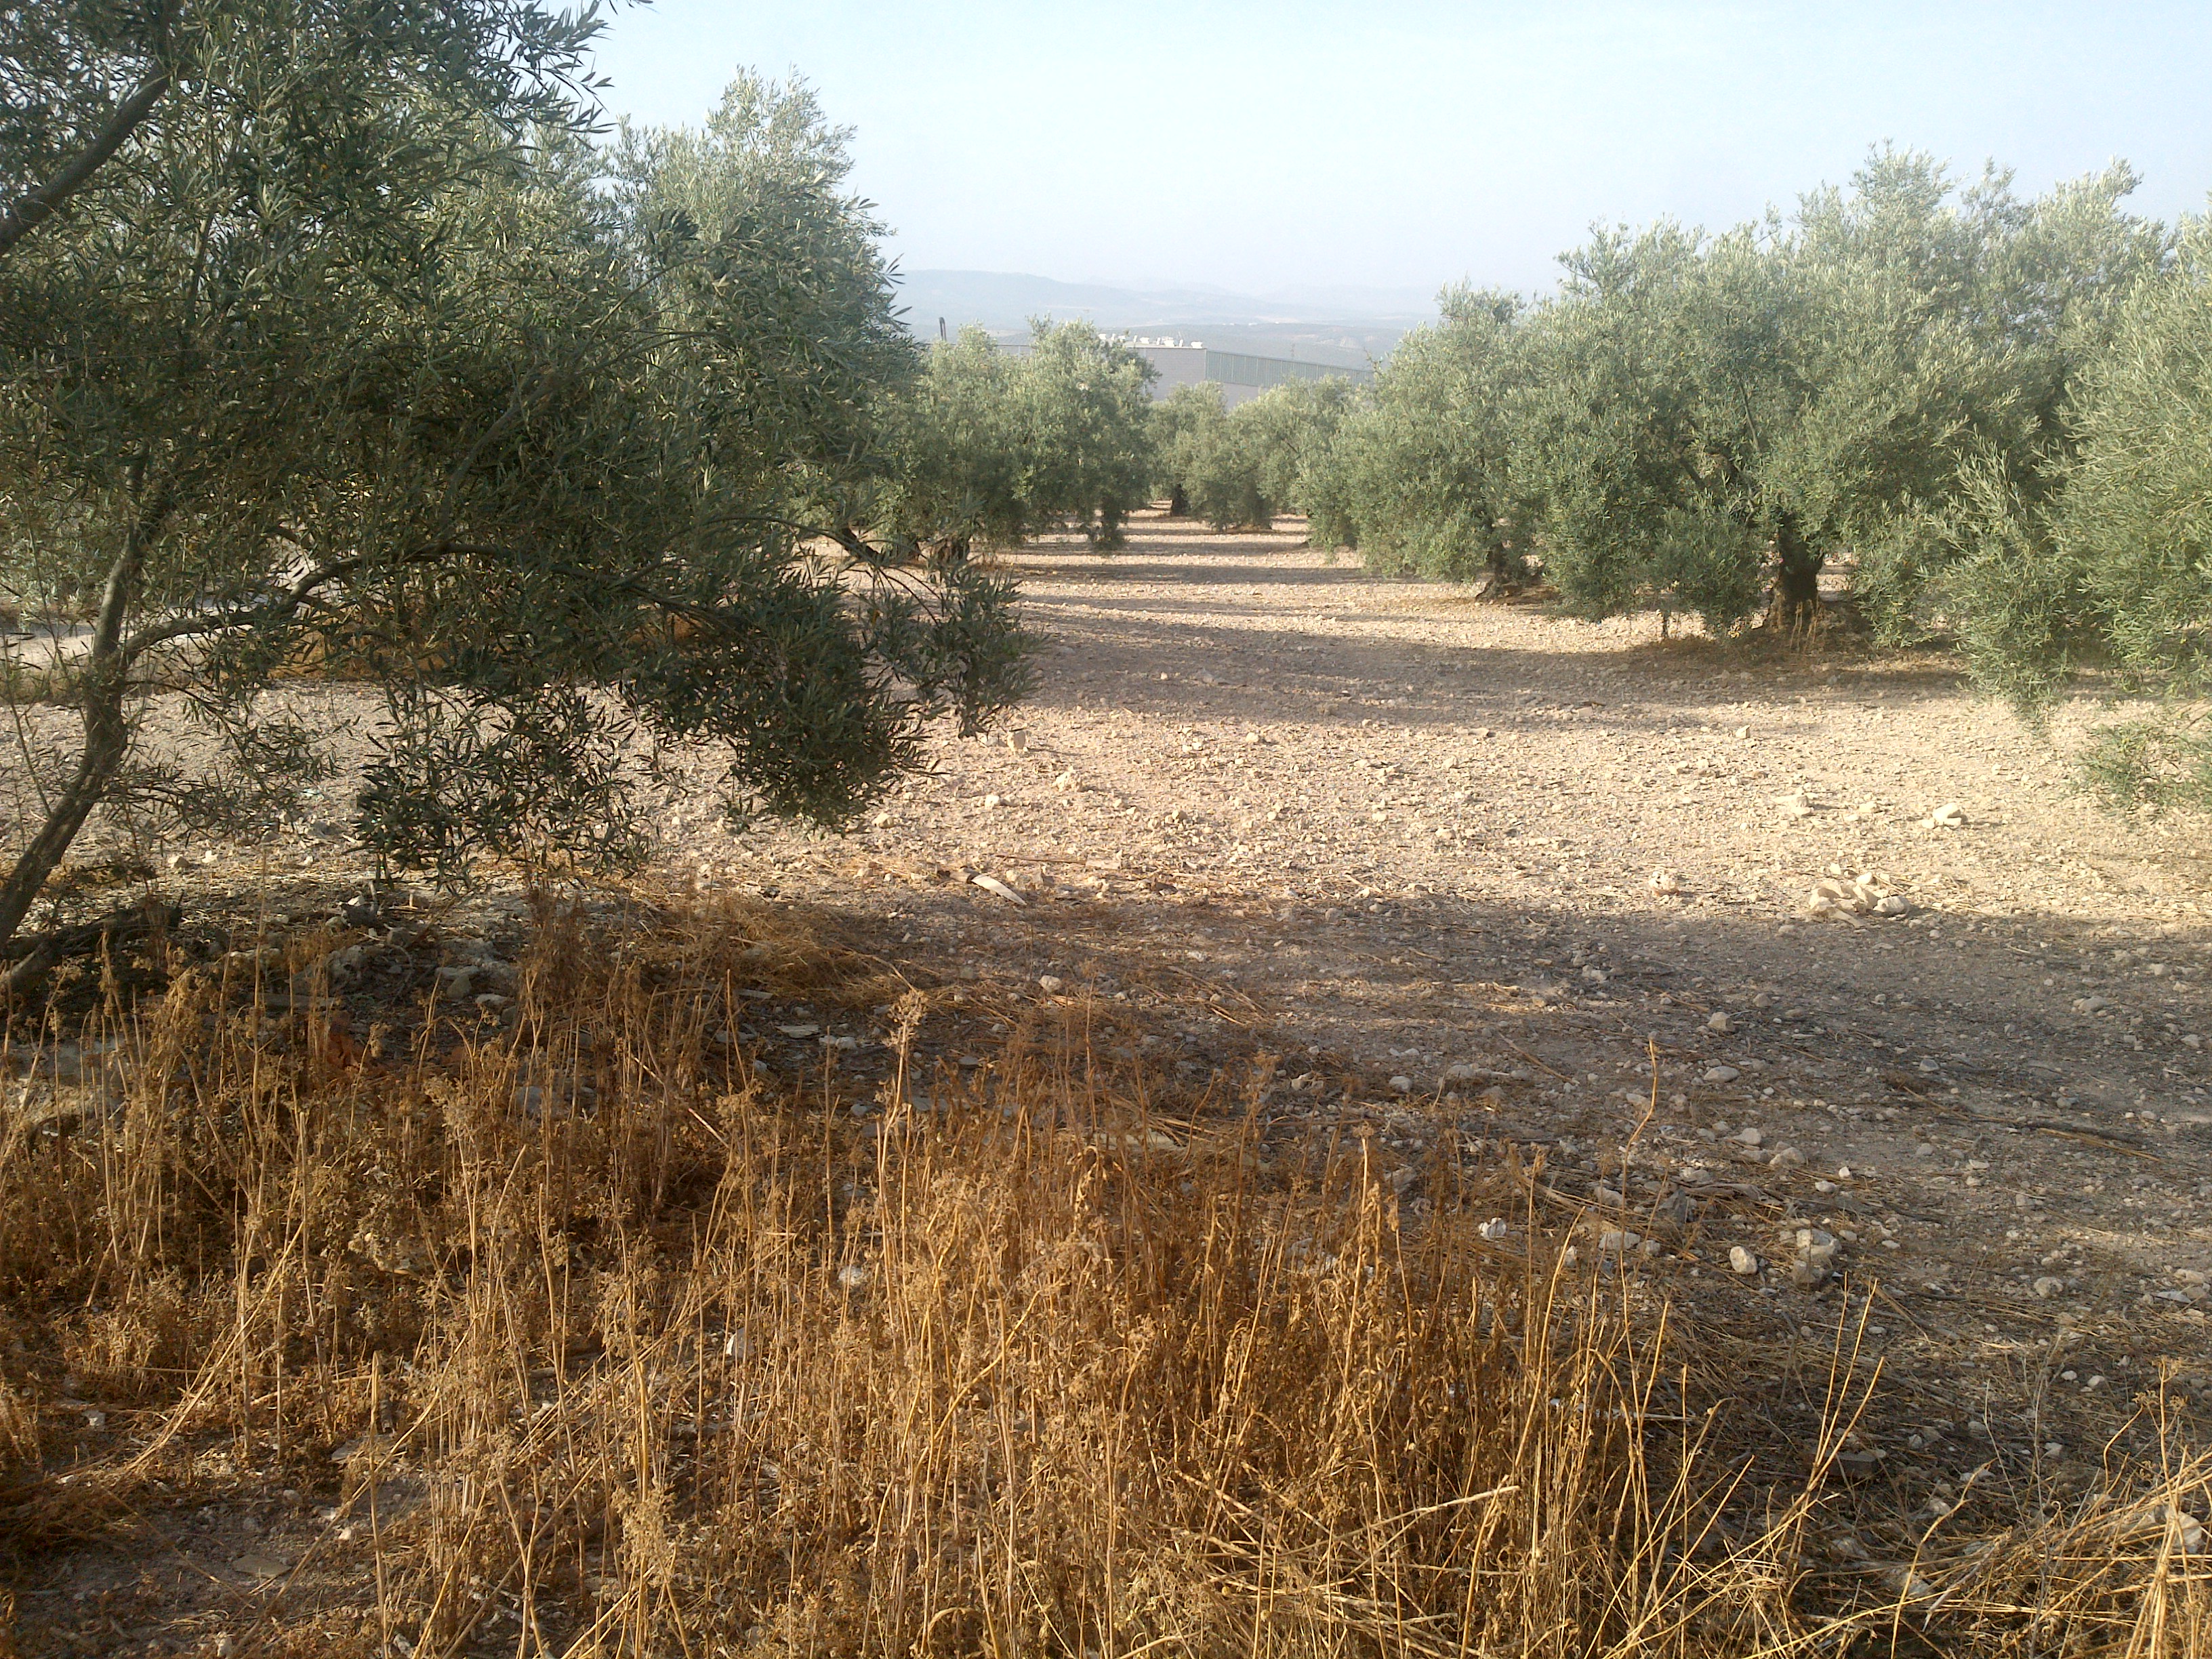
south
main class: Cropland
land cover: Olive groves
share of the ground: 25 - 50 %
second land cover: Spontaneously vegetated surfaces
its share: 25 - 50 %
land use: Agriculture (excluding fallow land and kitchen gardens)
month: July
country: ES
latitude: 37.3671
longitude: -4.4890
